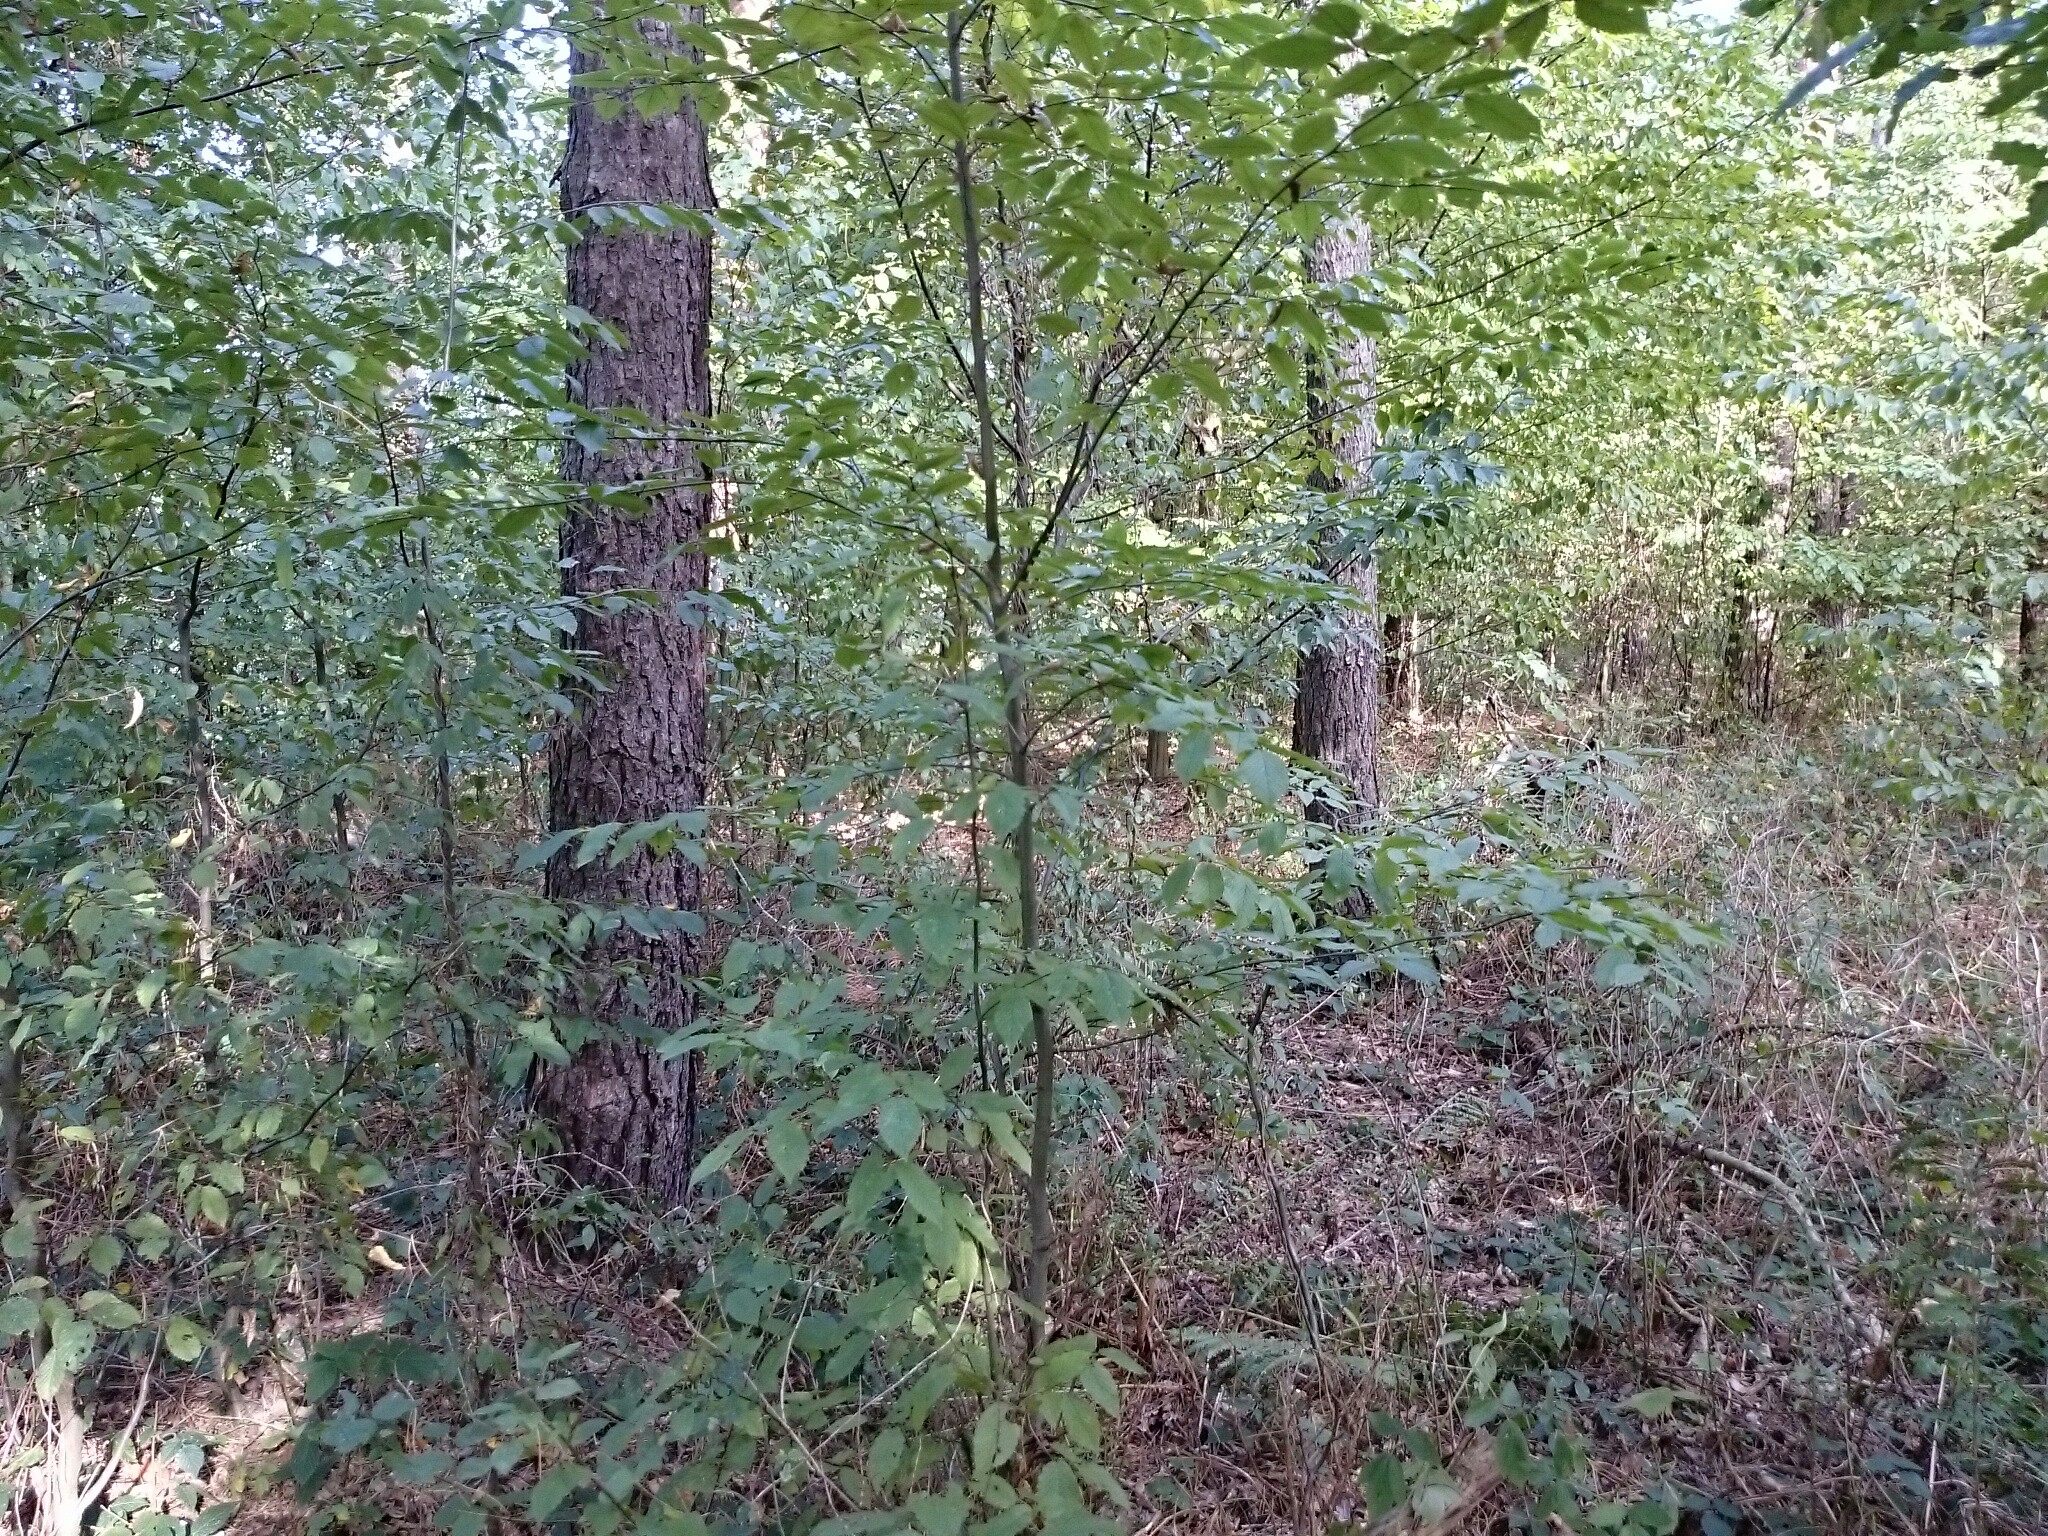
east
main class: Woodland
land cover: Pine dominated mixed woodland
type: hemiboreal forest and nemoral coniferous forest and mixed broadleaved-coniferous forest
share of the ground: > 75 %
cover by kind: coniferous forest trees 55 %, broadleaved forest trees 35 %, herbaceous plants 10 %
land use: Forestry
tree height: > 5 m
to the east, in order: Pine dominated mixed woodland; Tracks; Pine dominated mixed woodland
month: September
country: PL
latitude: 51.4642
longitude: 17.3385
